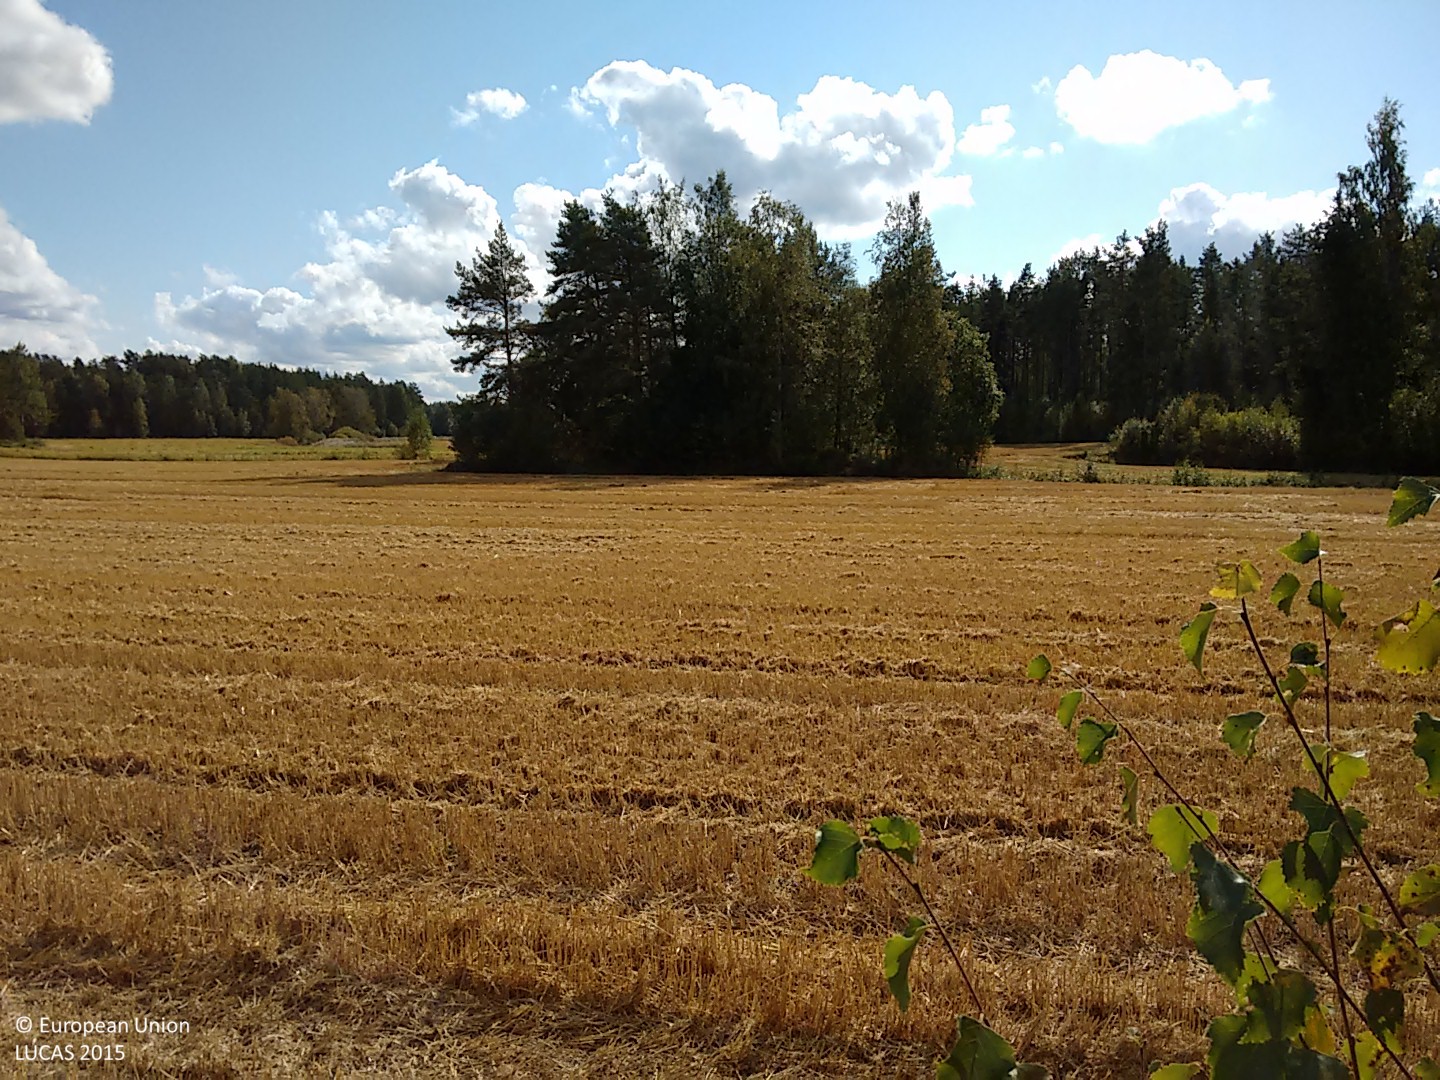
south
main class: Shrubland
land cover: Shrubland with sparse tree cover
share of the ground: > 75 %
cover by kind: shrubs 95 %, broadleaved forest trees 5 %
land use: Agriculture (excluding fallow land and kitchen gardens)
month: September
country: FI
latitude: 61.0234
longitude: 21.6952
